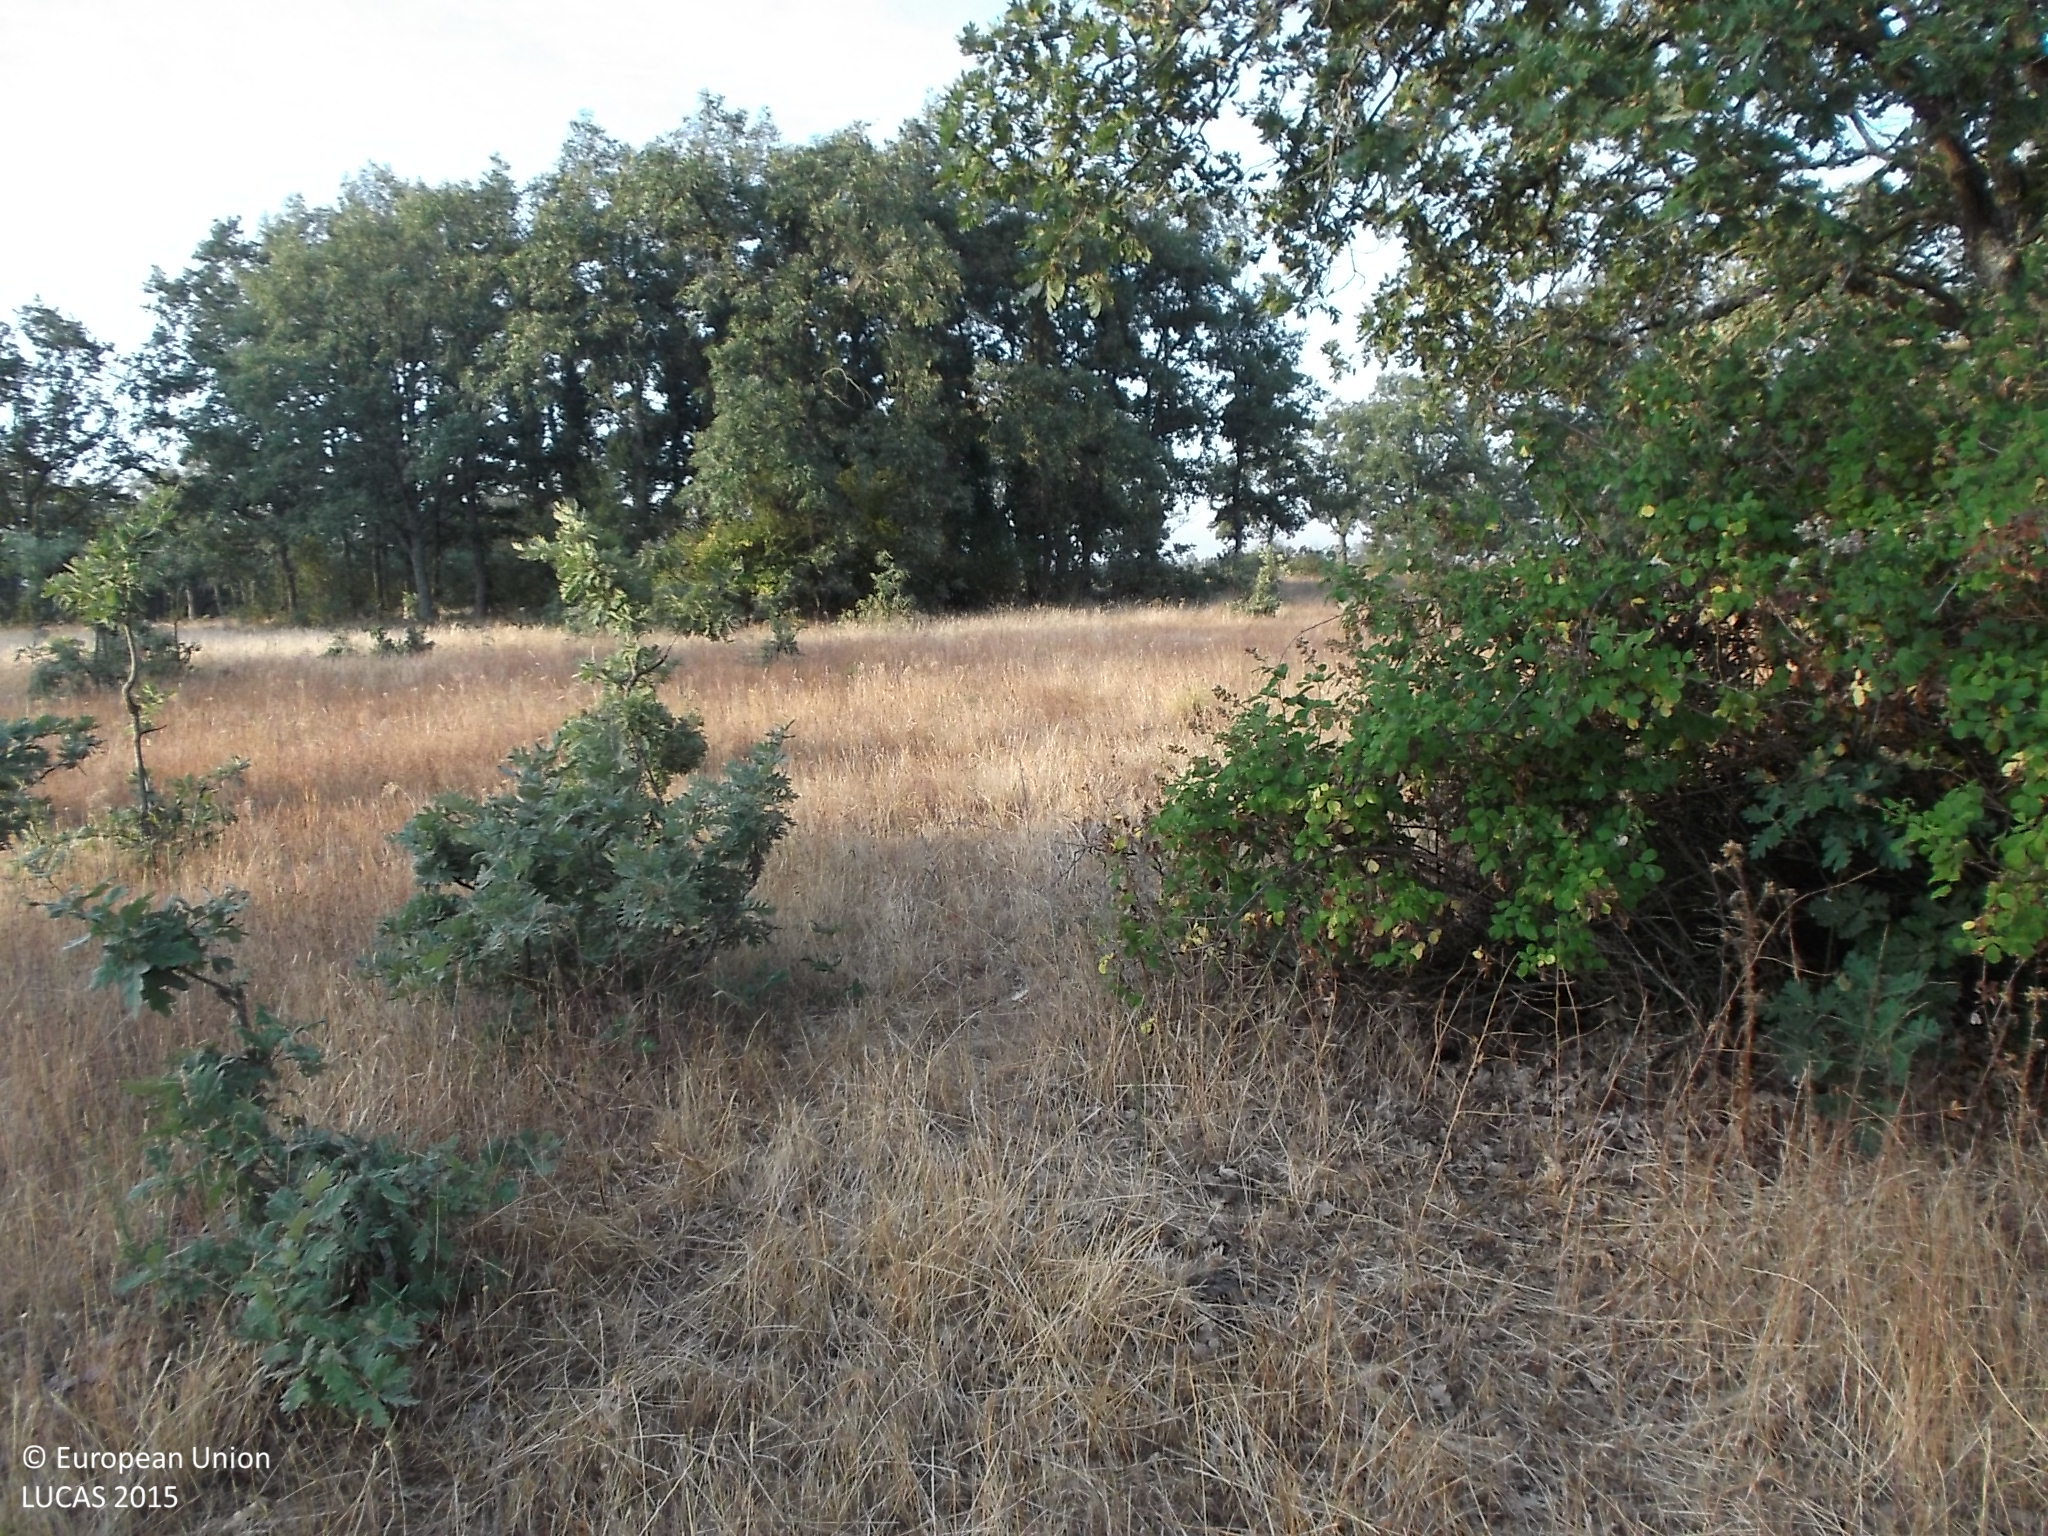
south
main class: Grassland
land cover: Grassland with sparse tree/shrub cover
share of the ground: > 75 %
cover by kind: herbaceous plants 90 %, broadleaved forest trees 5 %, shrubs 5 %
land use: Agriculture (excluding fallow land and kitchen gardens)
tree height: > 5 m
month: July
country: ES
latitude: 41.0541
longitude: -6.4795
